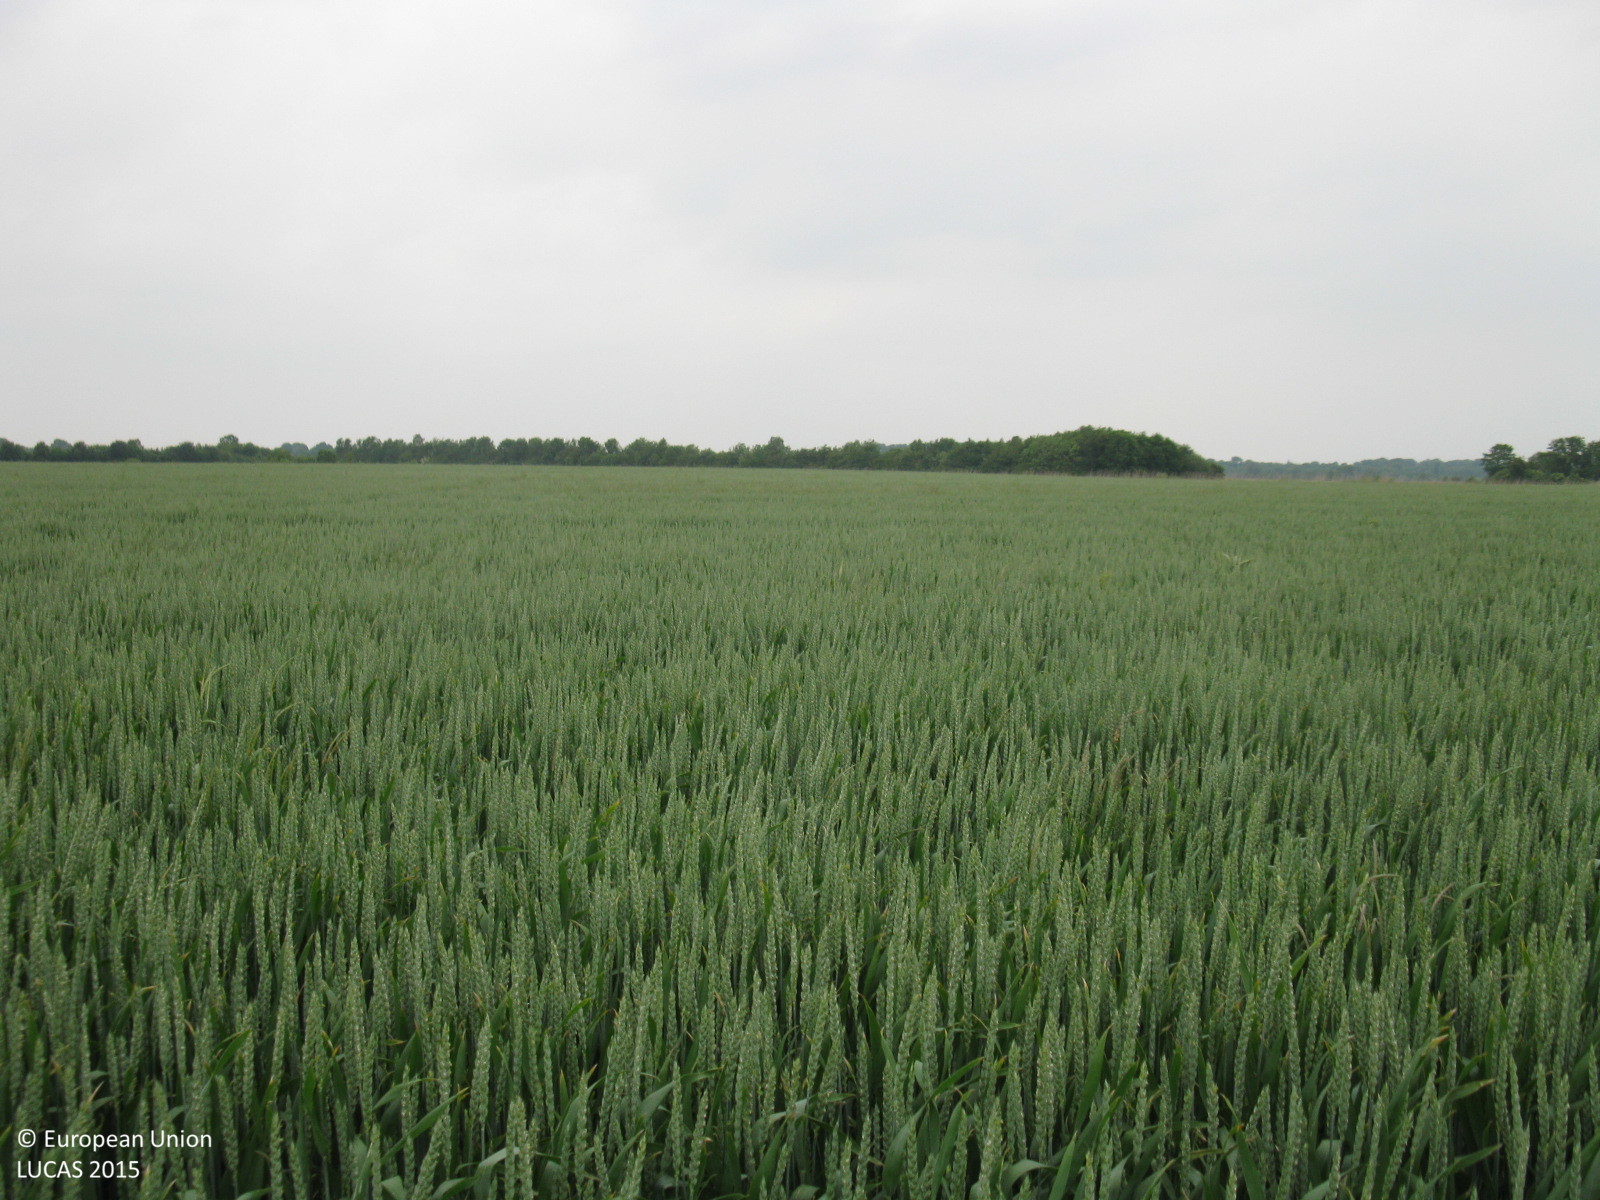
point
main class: Cropland
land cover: Common wheat
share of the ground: > 75 %
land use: Agriculture (excluding fallow land and kitchen gardens)
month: June
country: DE
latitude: 53.4971
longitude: 7.2722
